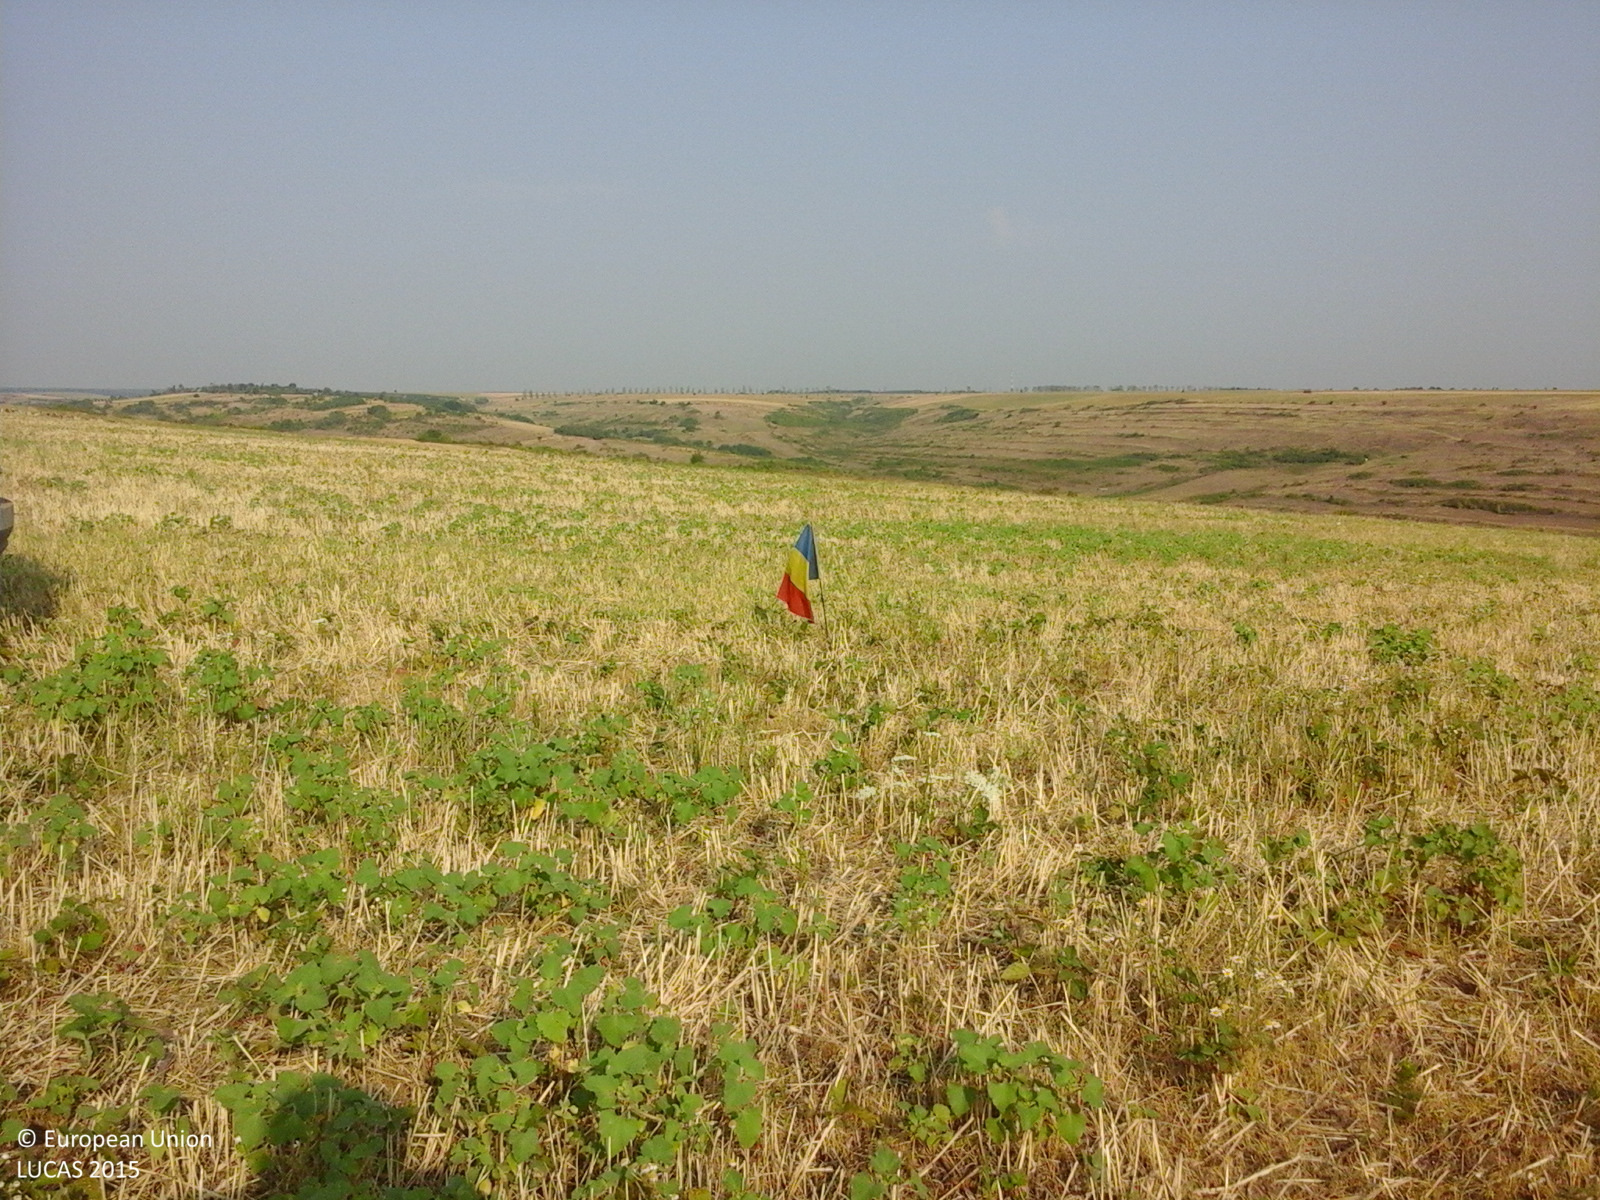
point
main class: Cropland
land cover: Barley
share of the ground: > 75 %
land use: Agriculture (excluding fallow land and kitchen gardens)
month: August
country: RO
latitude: 44.3488
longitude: 23.4361
